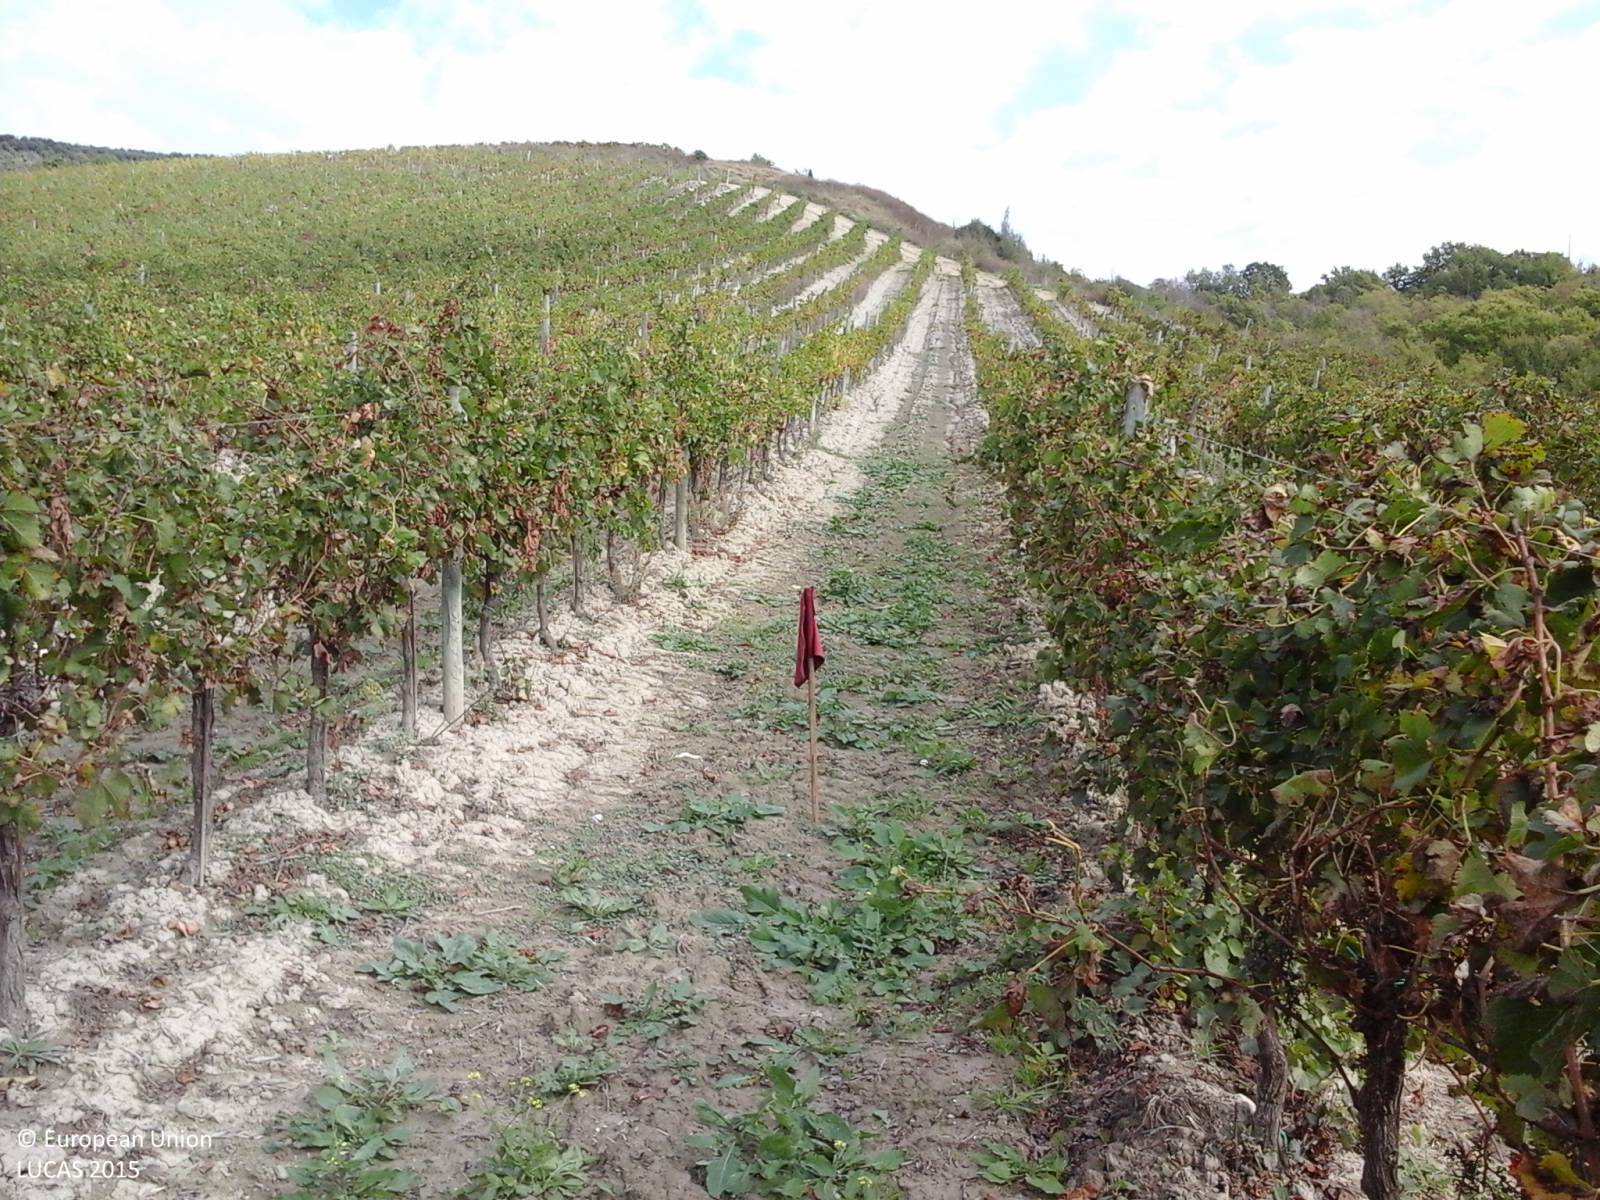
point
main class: Cropland
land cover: Vineyards
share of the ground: > 75 %
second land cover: Other bare soil
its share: > 75 %
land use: Agriculture (excluding fallow land and kitchen gardens)
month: October
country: IT
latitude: 42.6827
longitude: 12.2749
